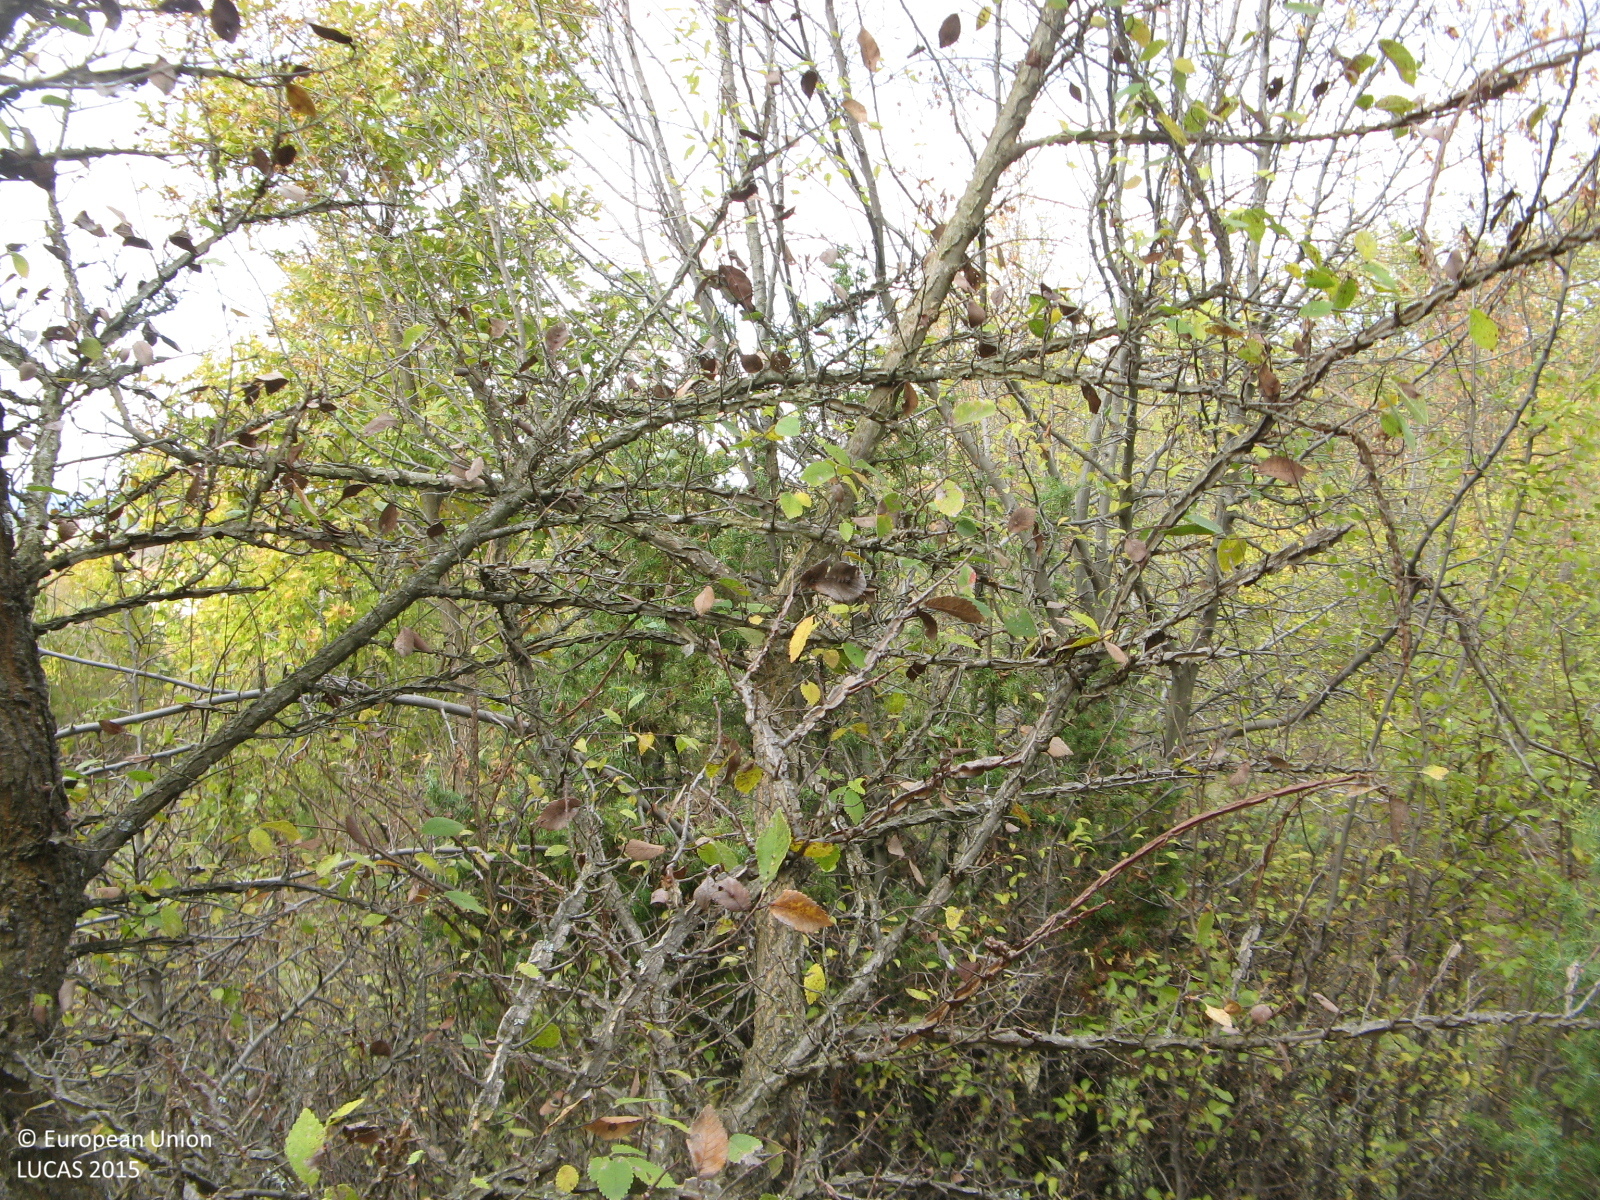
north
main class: Shrubland
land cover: Shrubland with sparse tree cover
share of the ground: > 75 %
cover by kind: shrubs 75 %, herbaceous plants 15 %, broadleaved forest trees 5 %, consolidated bare surface 5 %
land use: Agriculture (excluding fallow land and kitchen gardens)
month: November
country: BG
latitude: 41.4588
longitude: 25.3420
